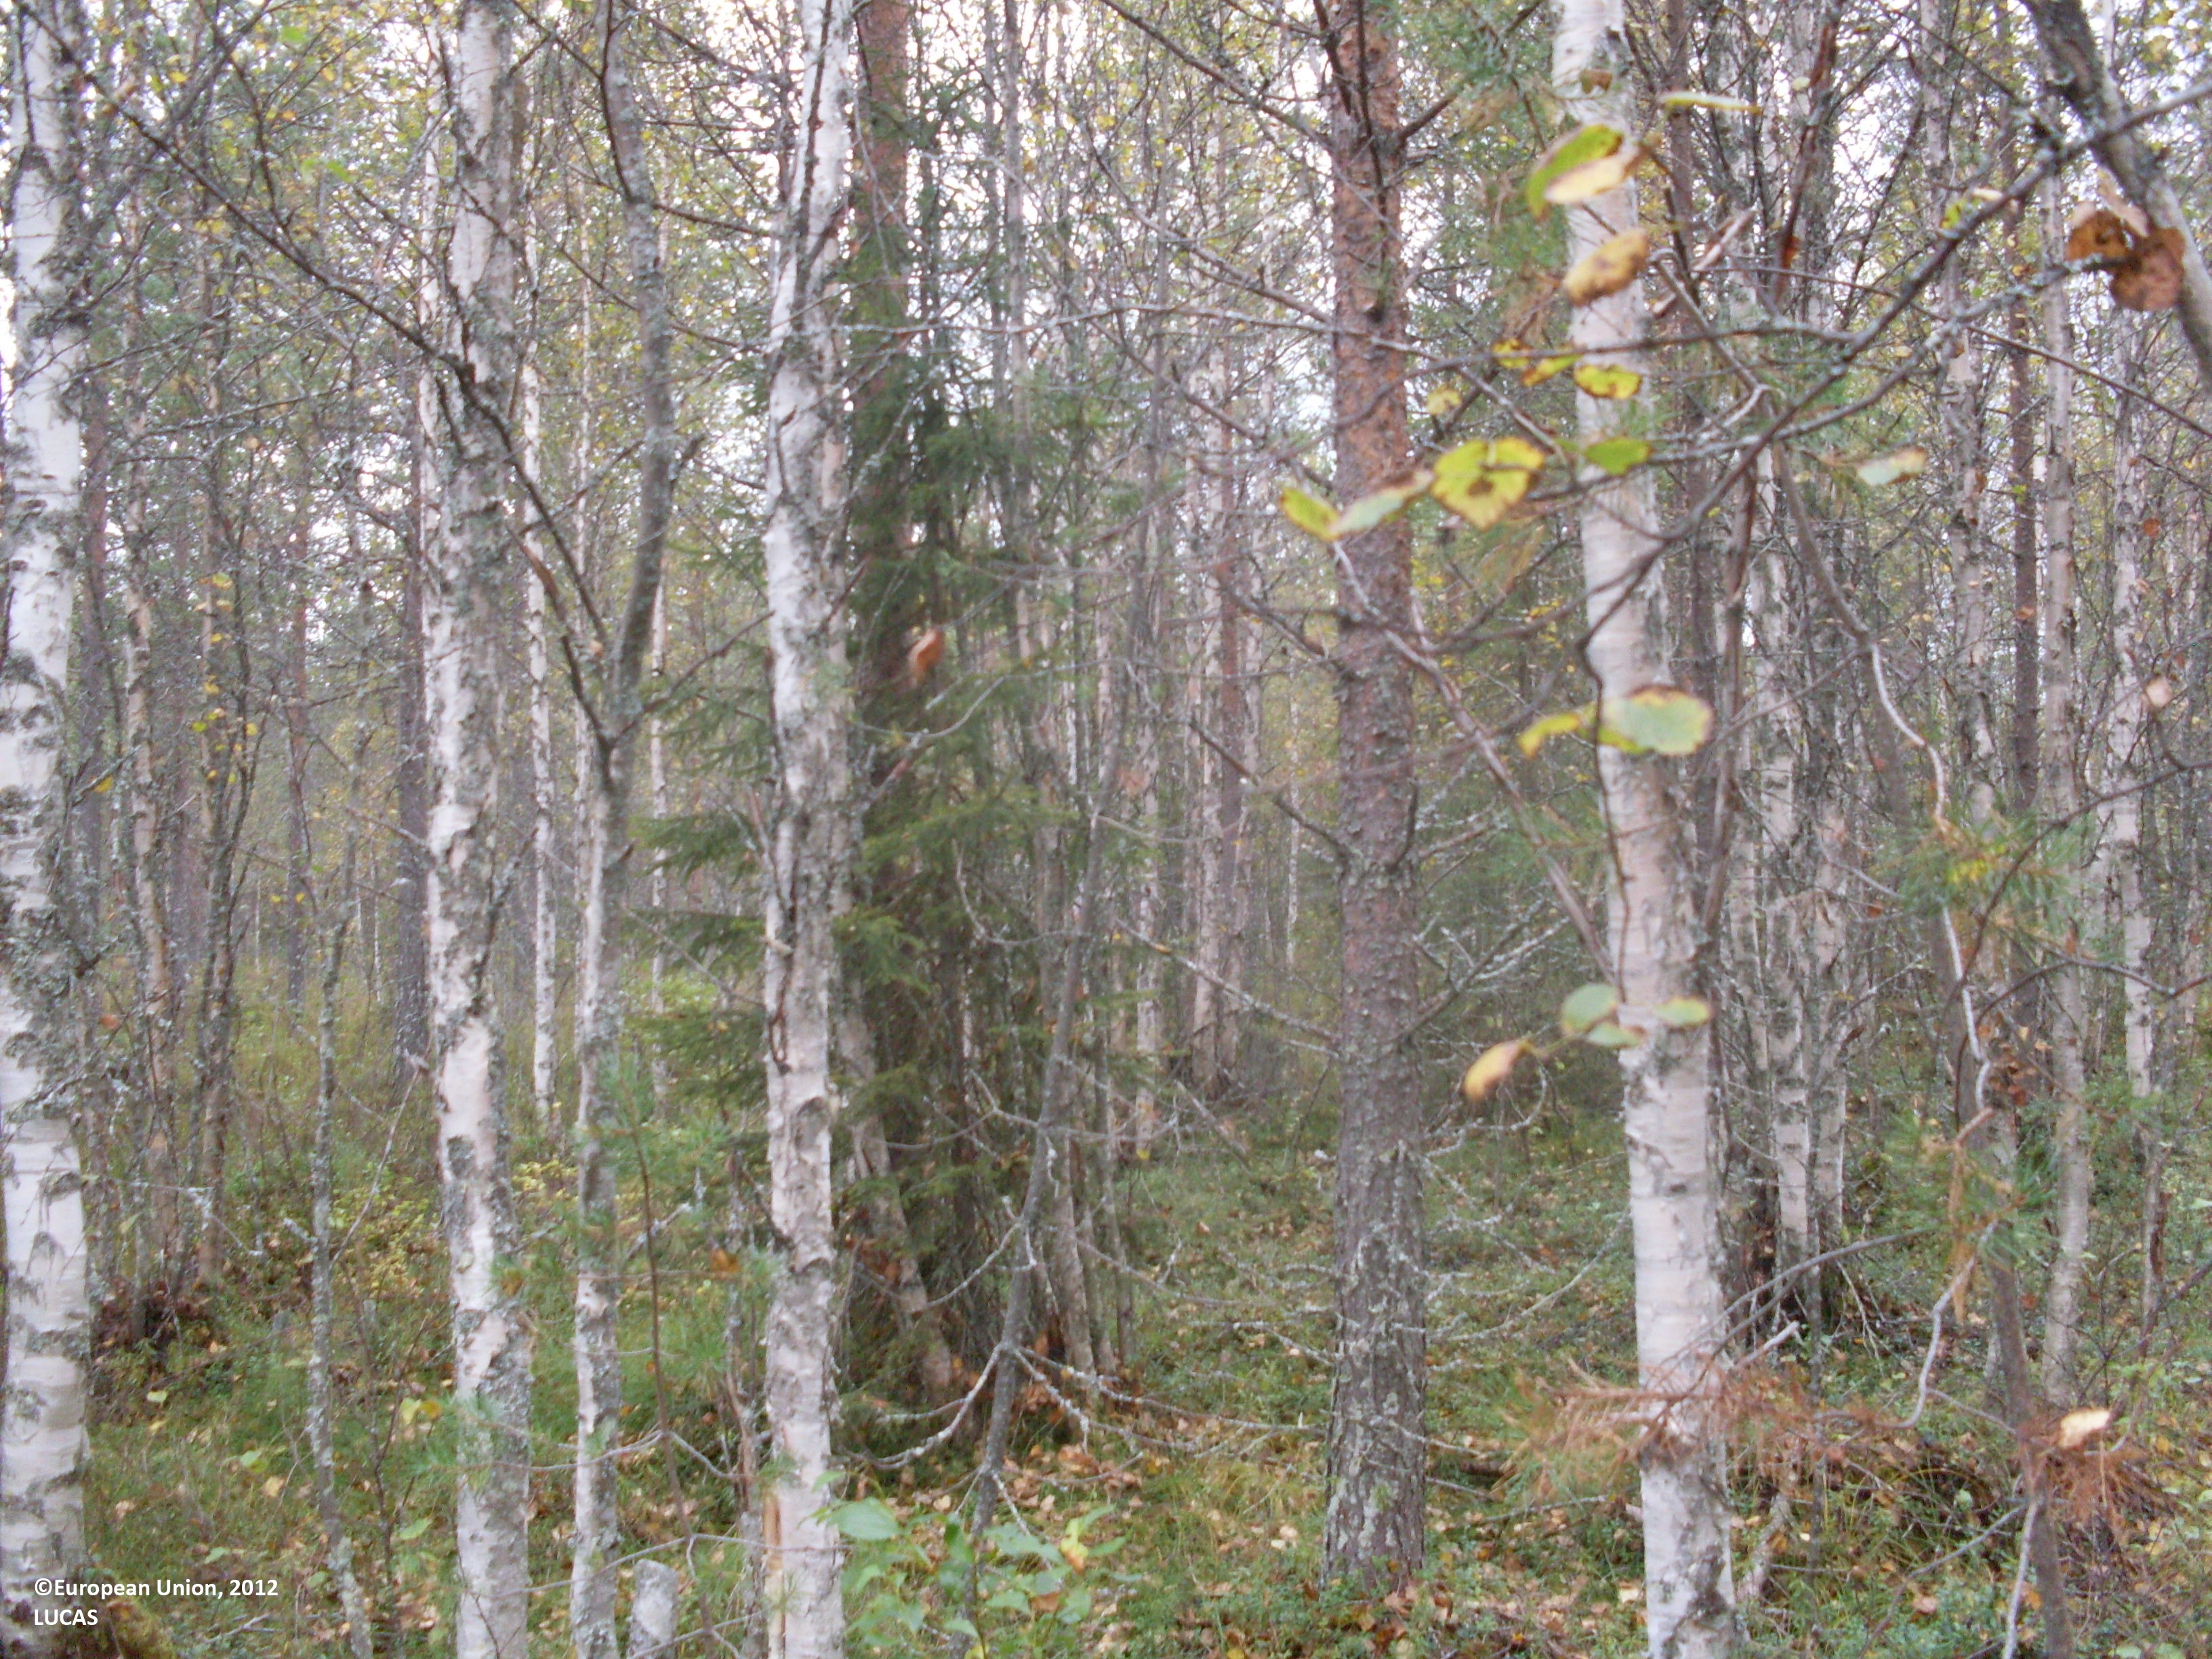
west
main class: Woodland
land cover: Other mixed woodland
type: boreal forest
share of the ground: 50 - 75 %
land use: Forestry
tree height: > 5 m
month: September
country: FI
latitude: 63.9750
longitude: 29.7814
